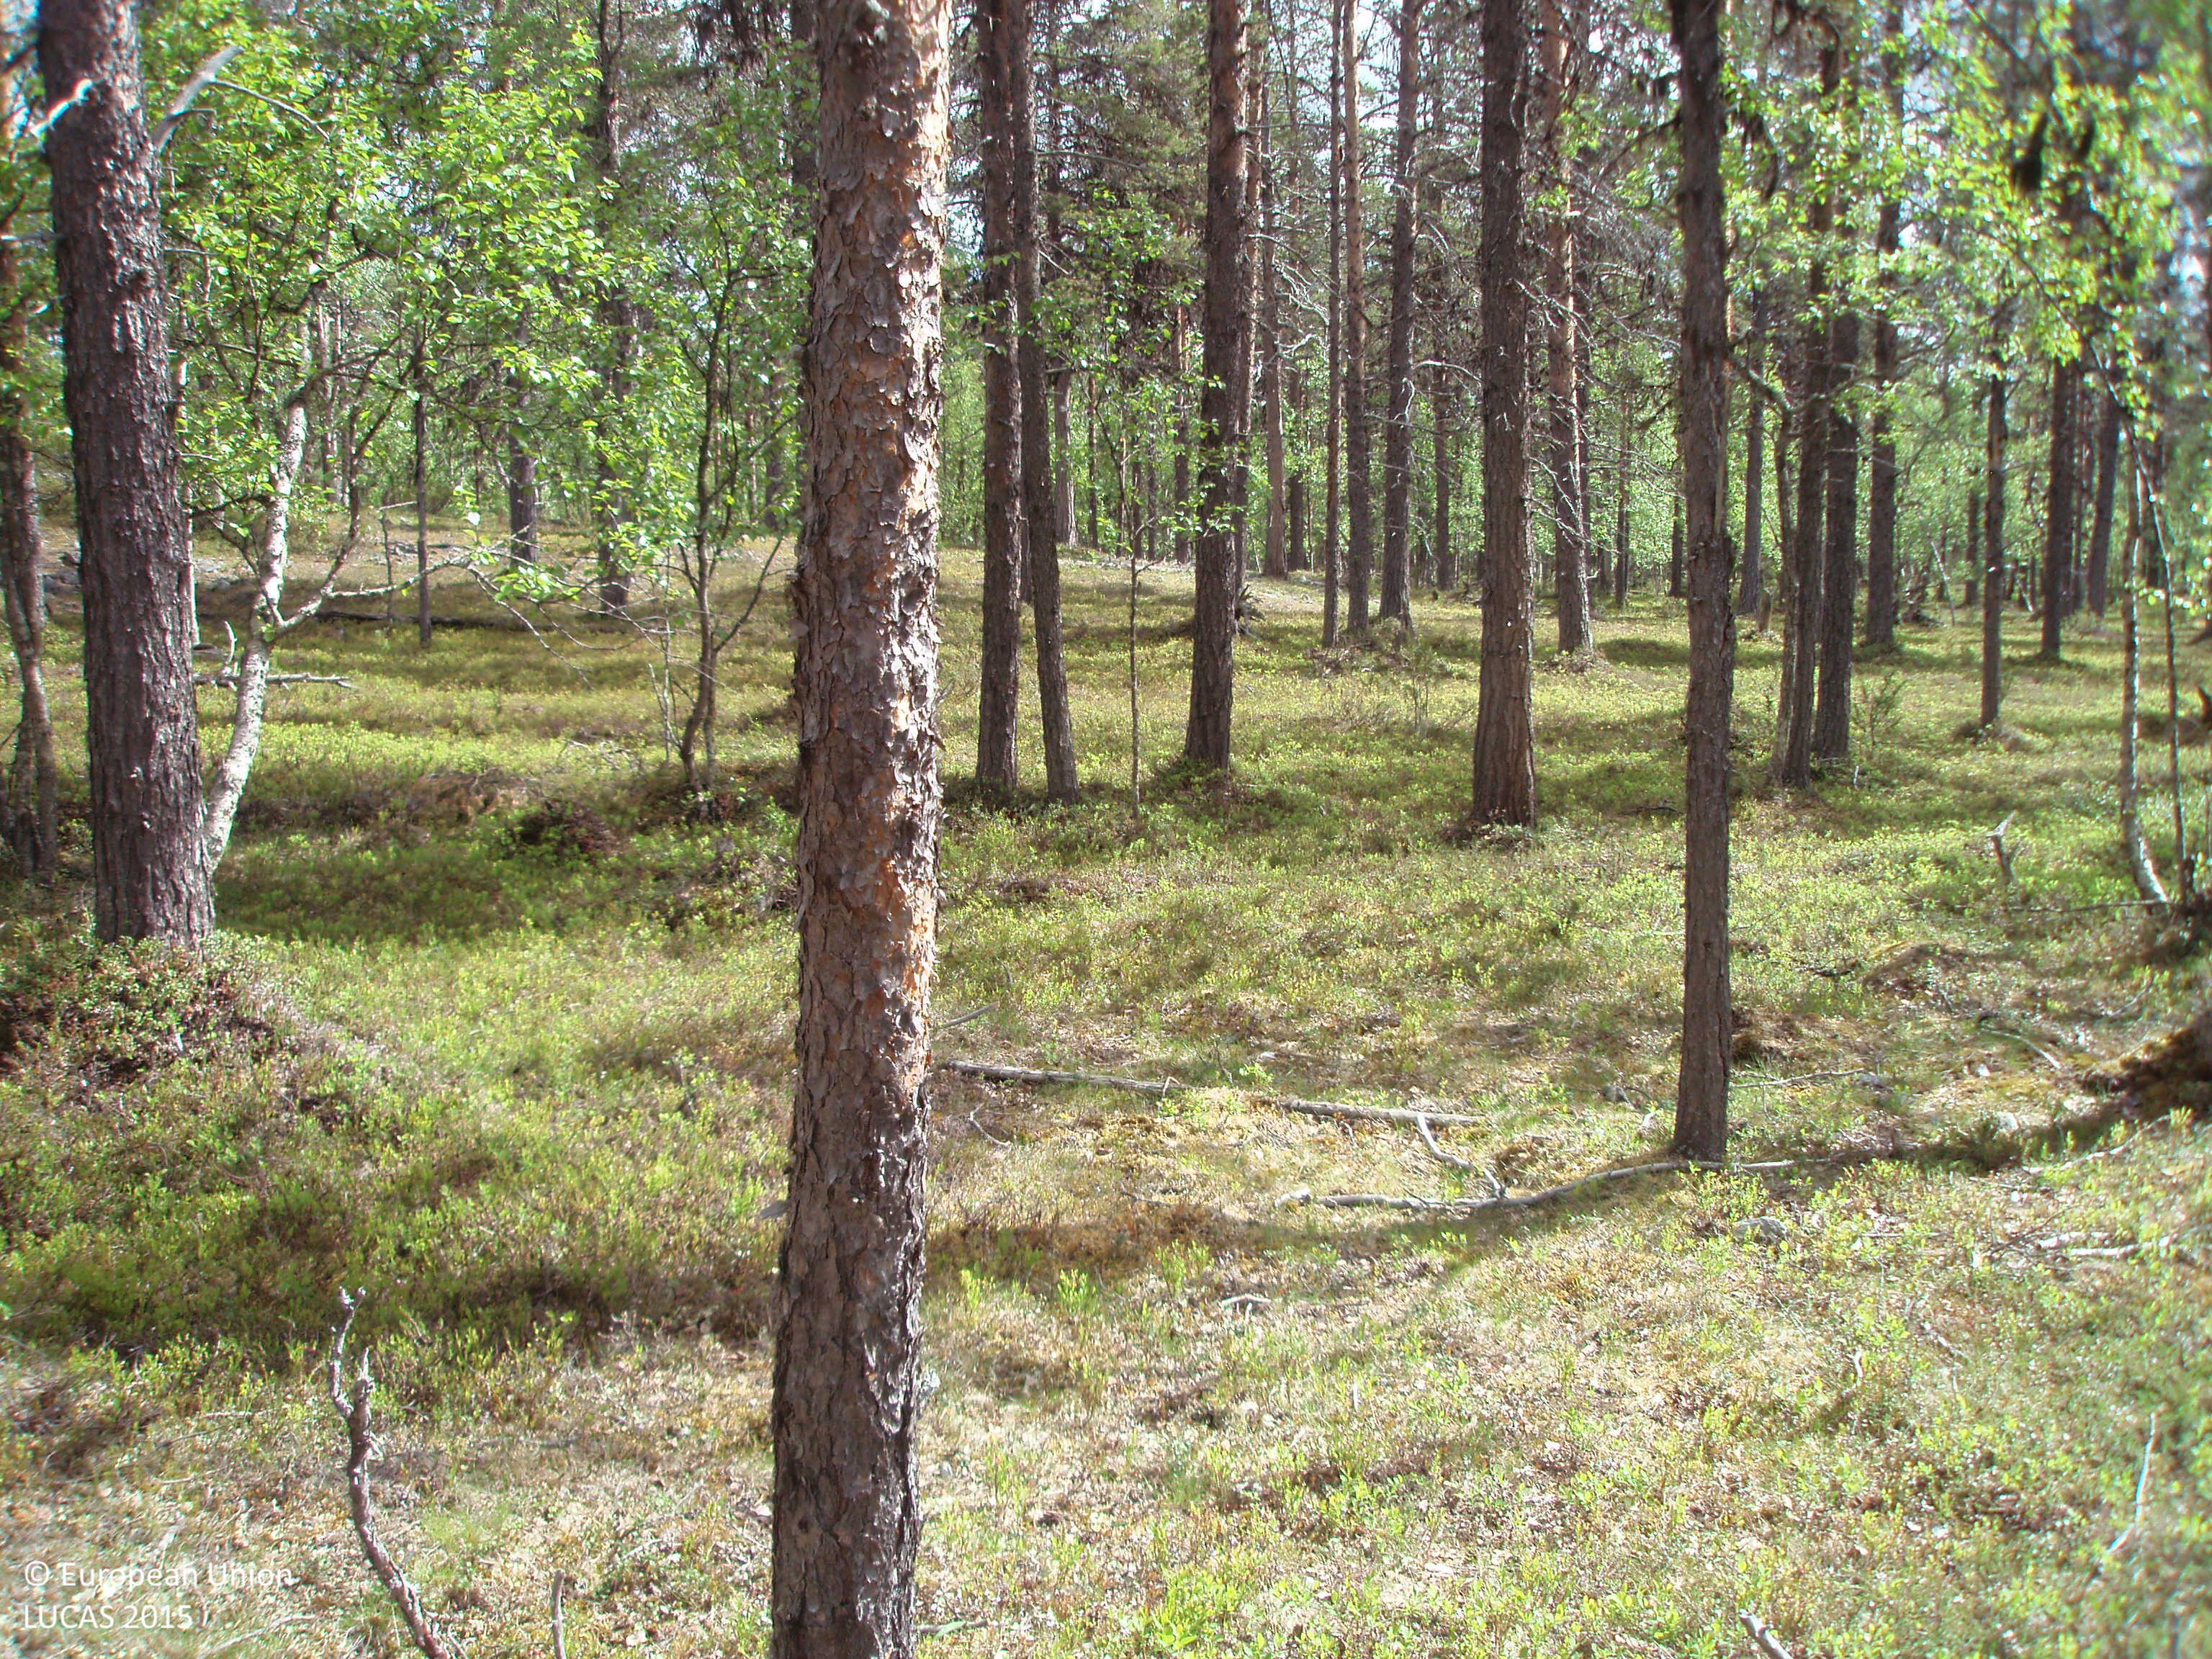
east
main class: Woodland
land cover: Pine dominated coniferous woodland
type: boreal forest
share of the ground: > 75 %
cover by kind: coniferous forest trees 70 %, shrubs 20 %, broadleaved forest trees 10 %
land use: Forestry
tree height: > 5 m
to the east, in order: Pine dominated coniferous woodland; Pine dominated mixed woodland; Rivers and streams; Pine dominated mixed woodland; Shruby margins; Ditches and canals; Shruby margins; Paved roads, cycling and walking lanes
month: June
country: FI
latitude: 68.4322
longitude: 25.9115
